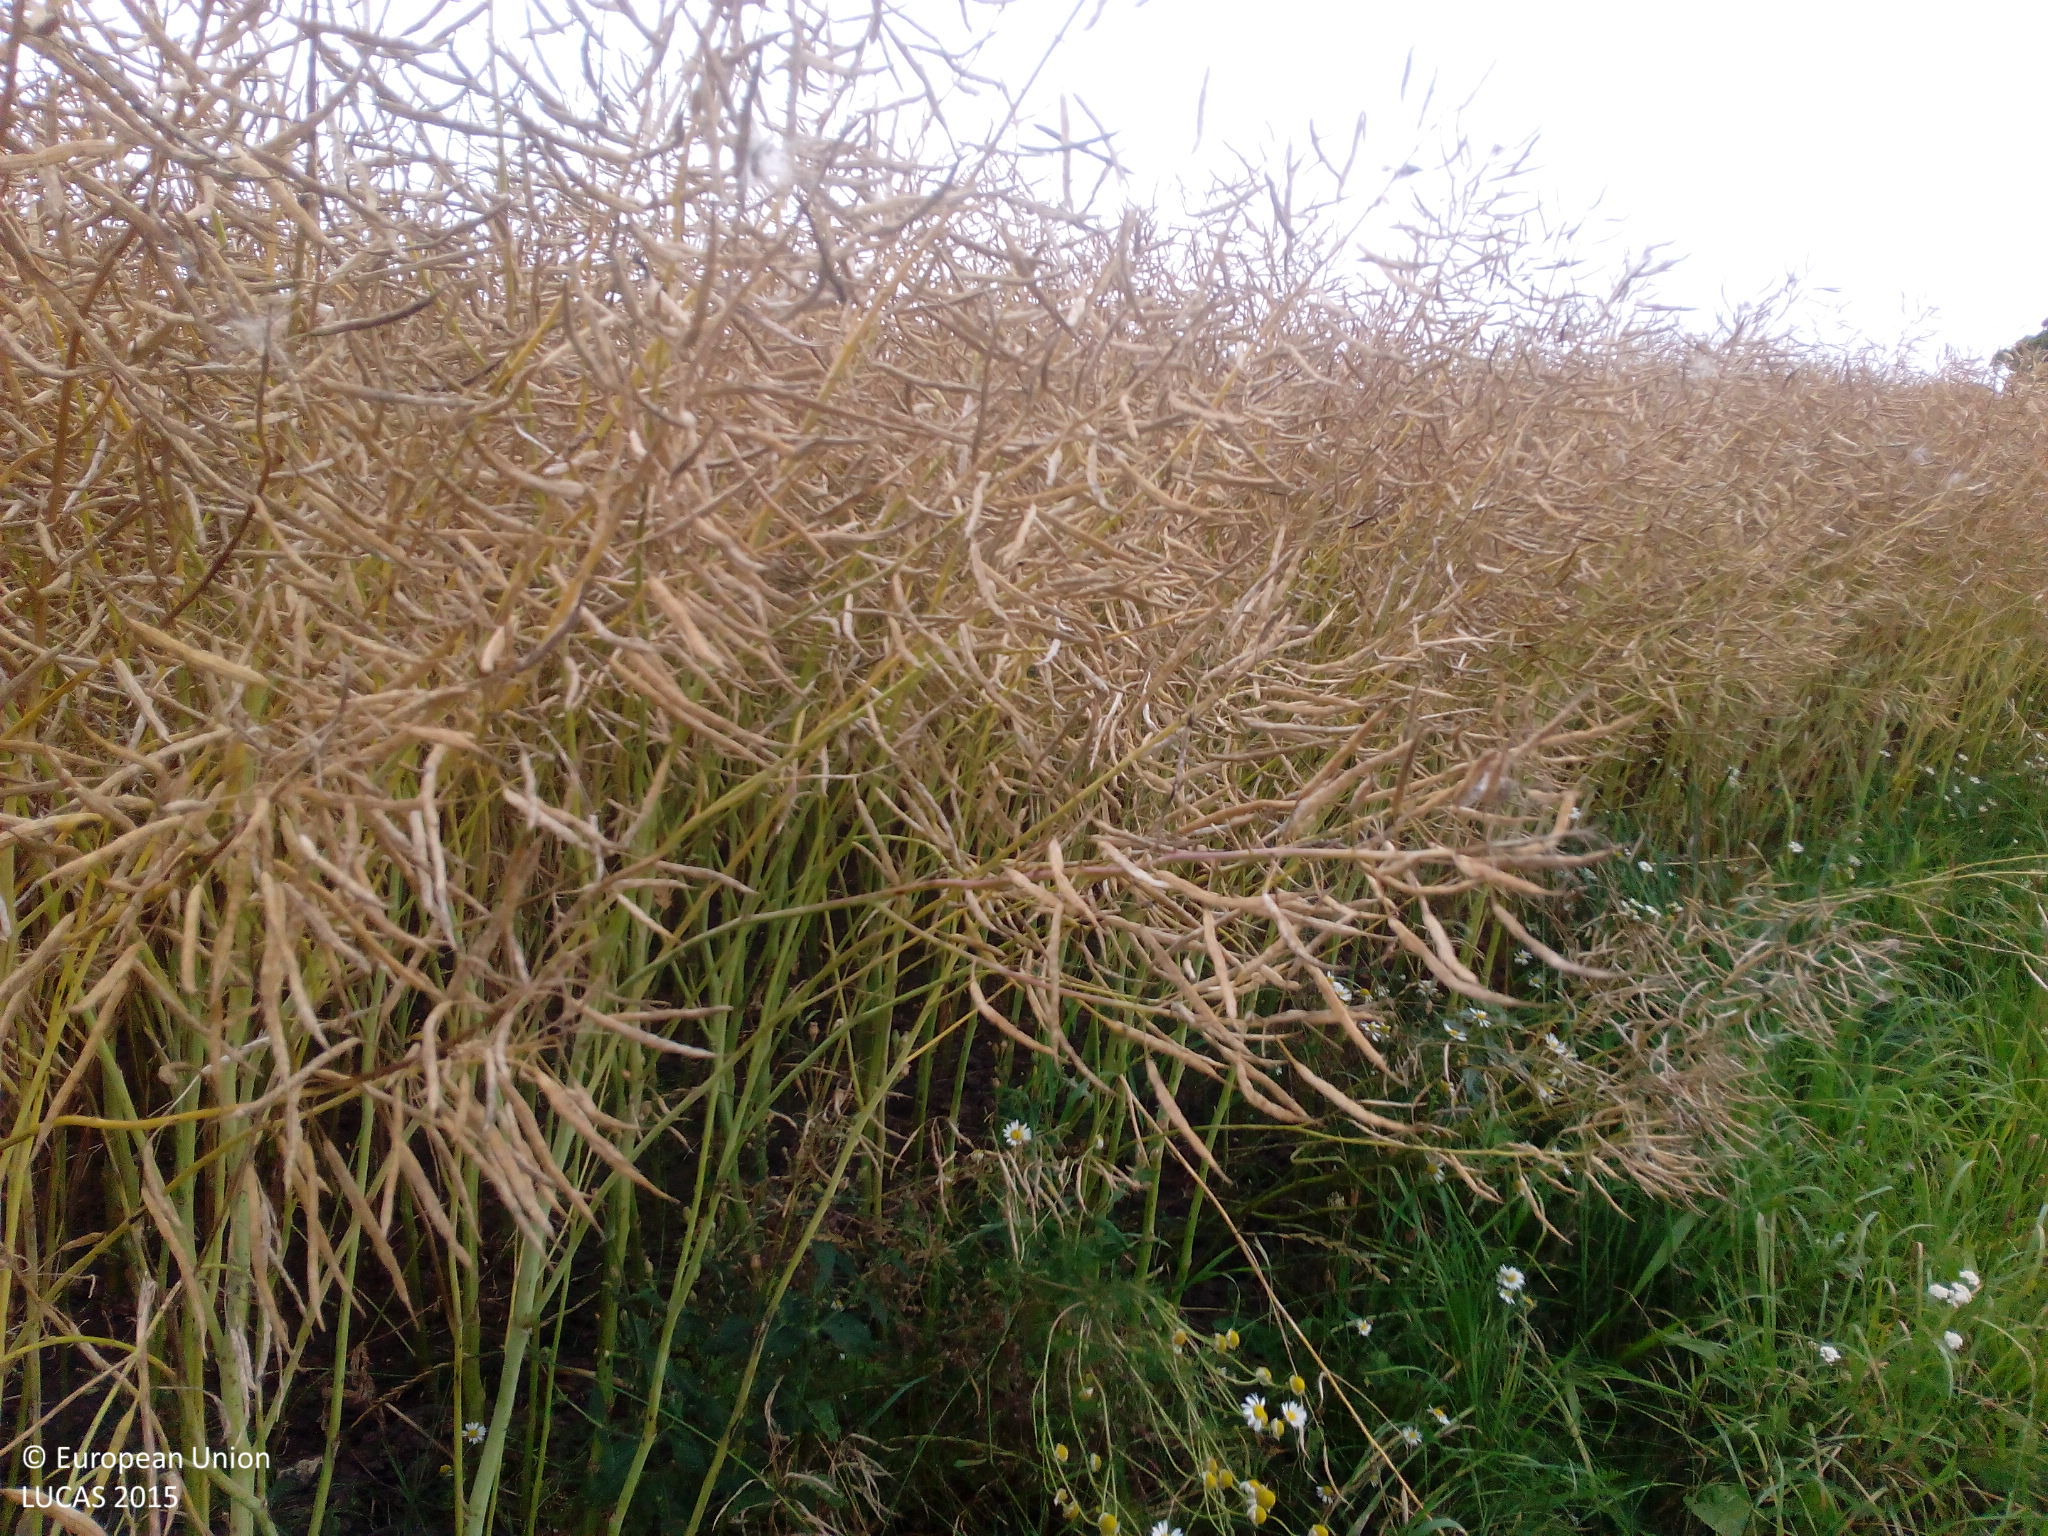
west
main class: Cropland
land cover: Temporary grasslands
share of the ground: > 75 %
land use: Agriculture (excluding fallow land and kitchen gardens)
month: August
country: DK
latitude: 55.5616
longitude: 11.9486
